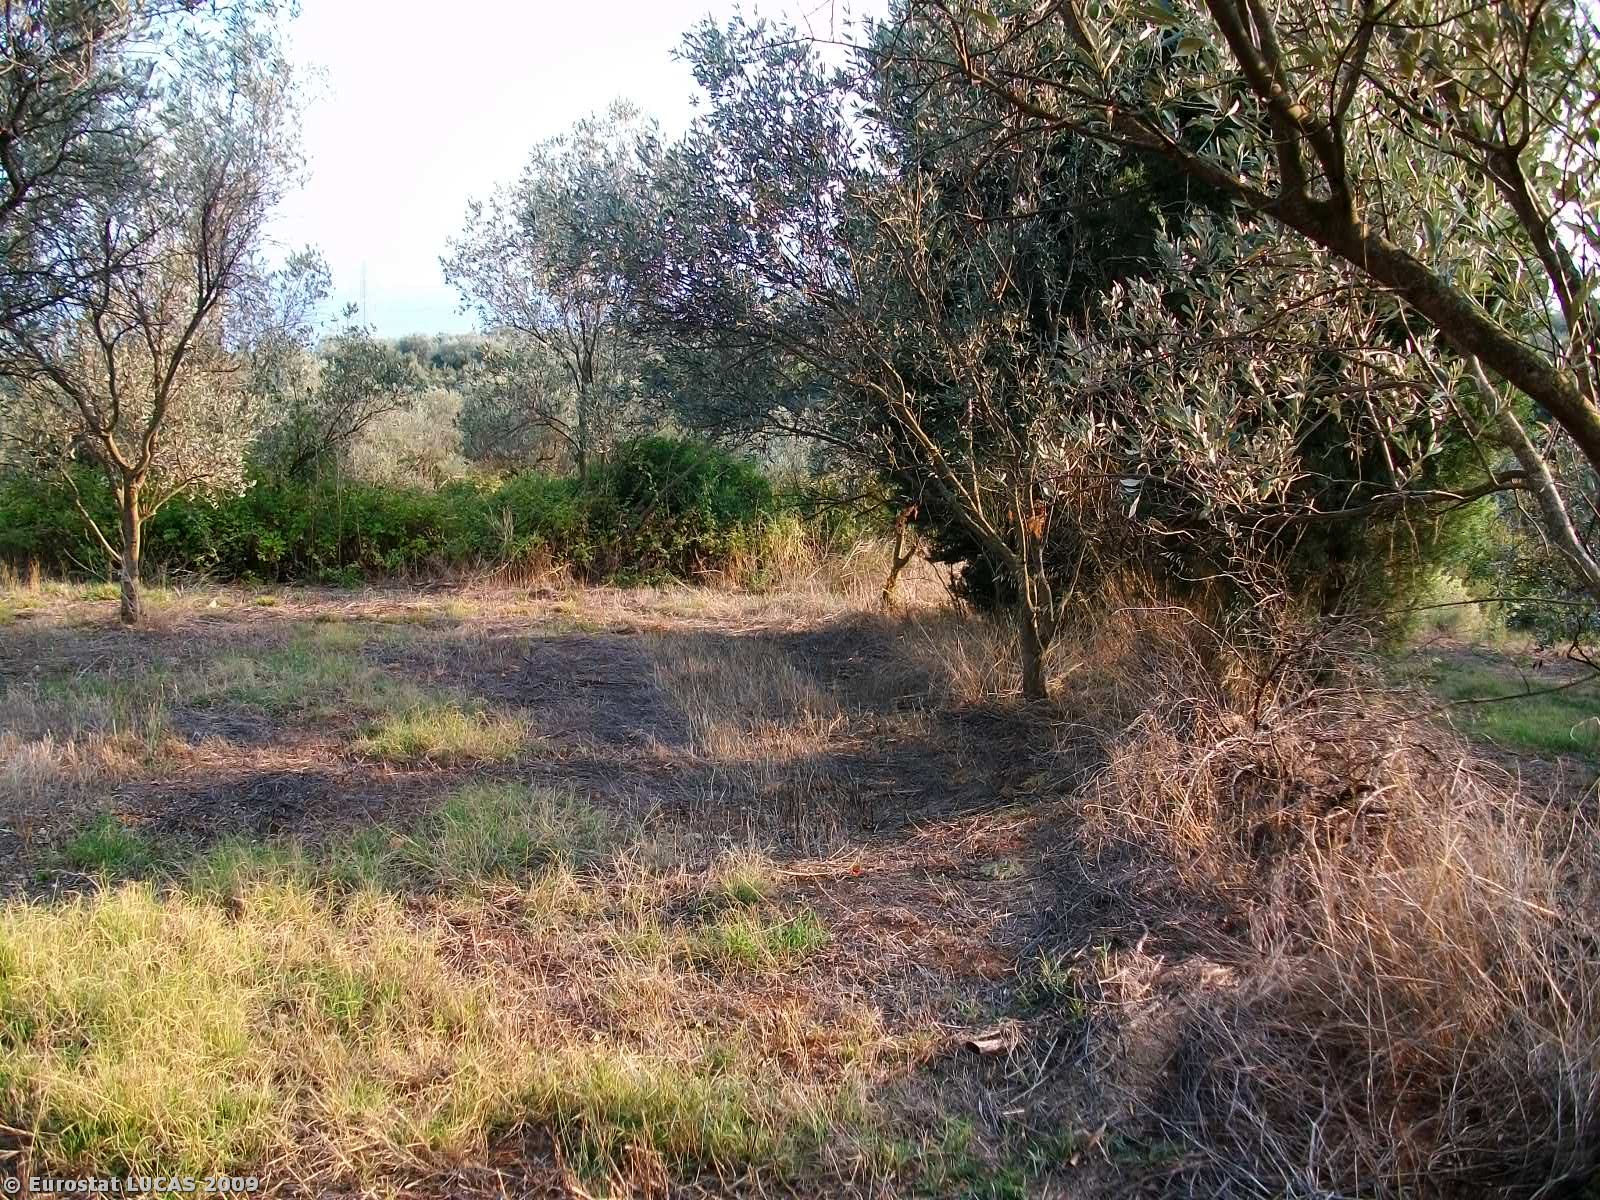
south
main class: Cropland
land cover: Olive groves
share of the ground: 50 - 75 %
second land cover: Grassland with sparse tree/shrub cover
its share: > 75 %
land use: Agriculture (excluding fallow land and kitchen gardens)
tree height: < 5 m
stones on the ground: 10 - 25 %
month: September
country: GR
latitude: 38.6216
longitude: 21.4907
